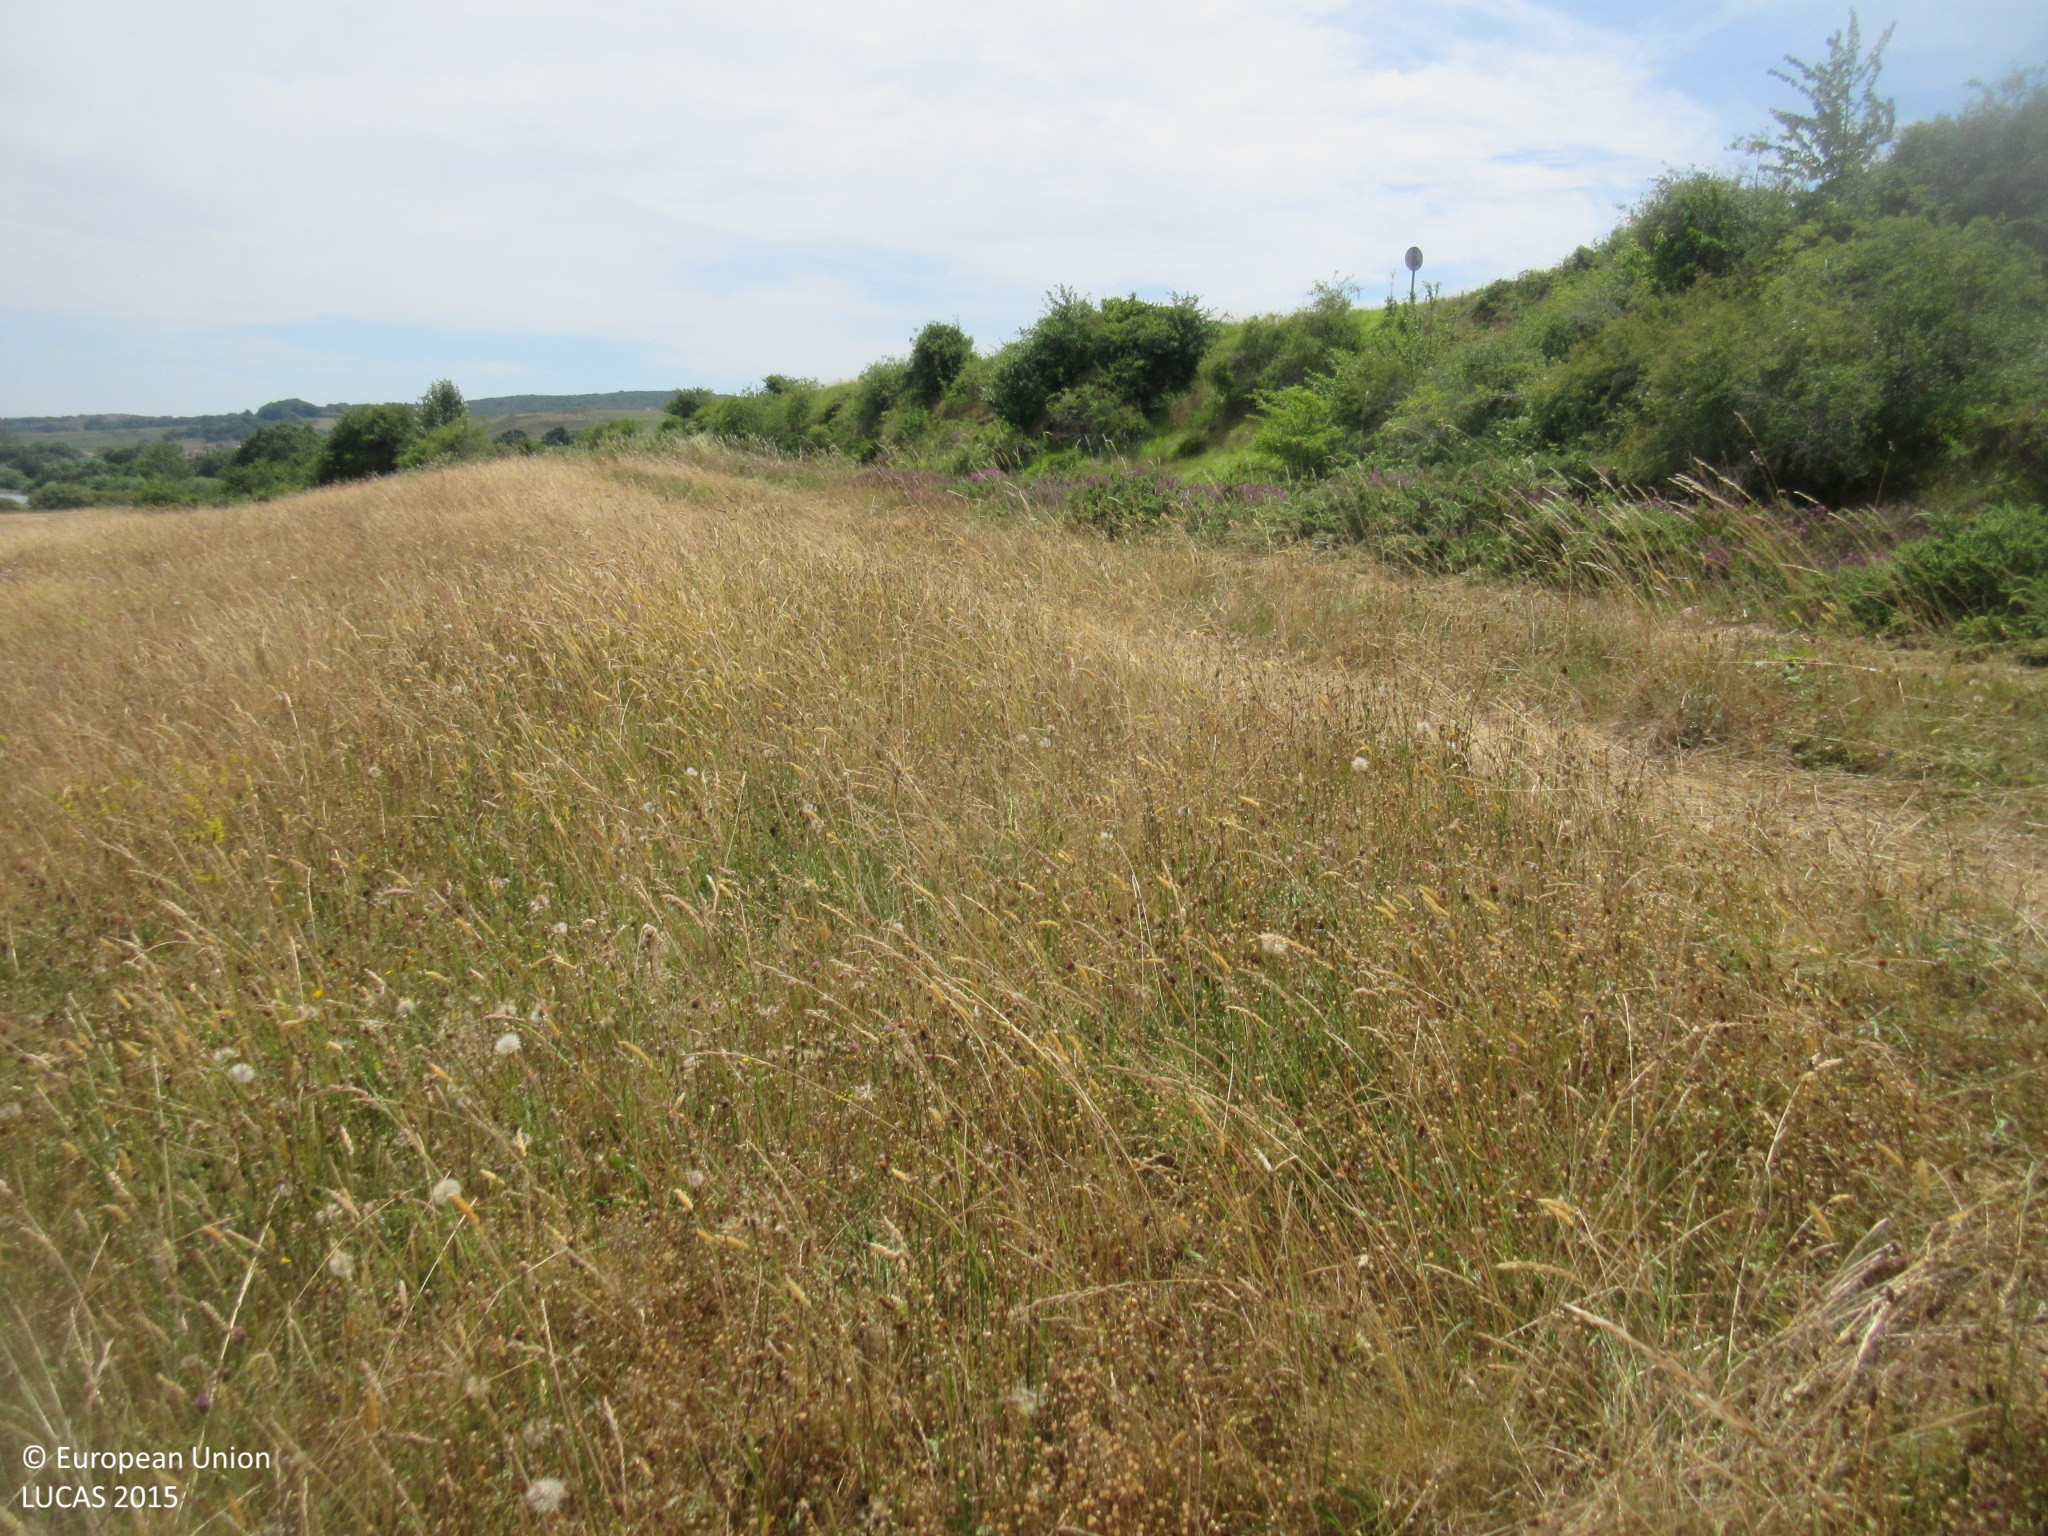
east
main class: Grassland
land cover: Grassland without tree/shrub cover
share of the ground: > 75 %
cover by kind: herbaceous plants 100 %
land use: Agriculture (excluding fallow land and kitchen gardens)
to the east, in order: Grassland without tree/shrub cover; Shruby margins; Railways; Shrubland with sparse tree cover; Grassland without tree/shrub cover; Shrubland with sparse tree cover
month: July
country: ES
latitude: 42.9735
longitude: -4.0136
